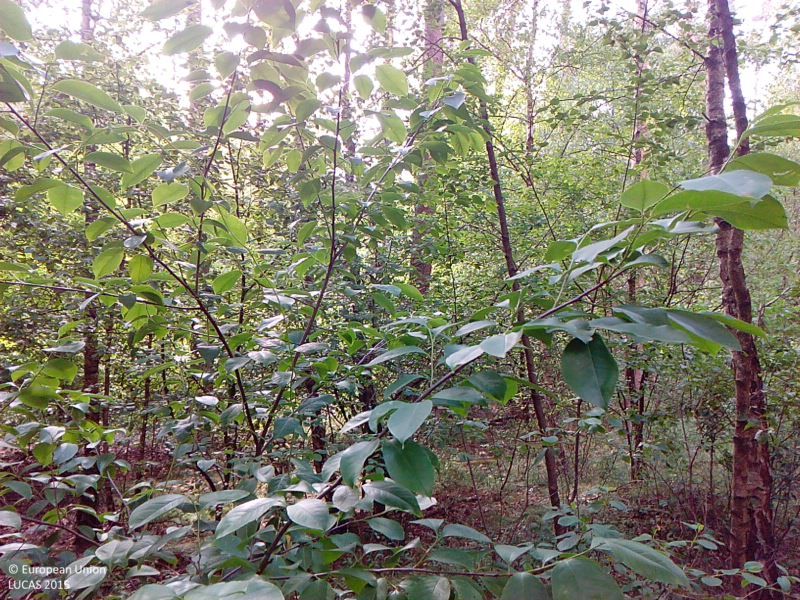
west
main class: Woodland
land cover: Pine dominated mixed woodland
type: hemiboreal forest and nemoral coniferous forest and mixed broadleaved-coniferous forest
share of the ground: > 75 %
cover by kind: coniferous forest trees 40 %, broadleaved forest trees 35 %, shrubs 15 %, herbaceous plants 10 %
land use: Forestry
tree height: > 5 m
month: June
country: DE
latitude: 52.4940
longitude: 7.4523
